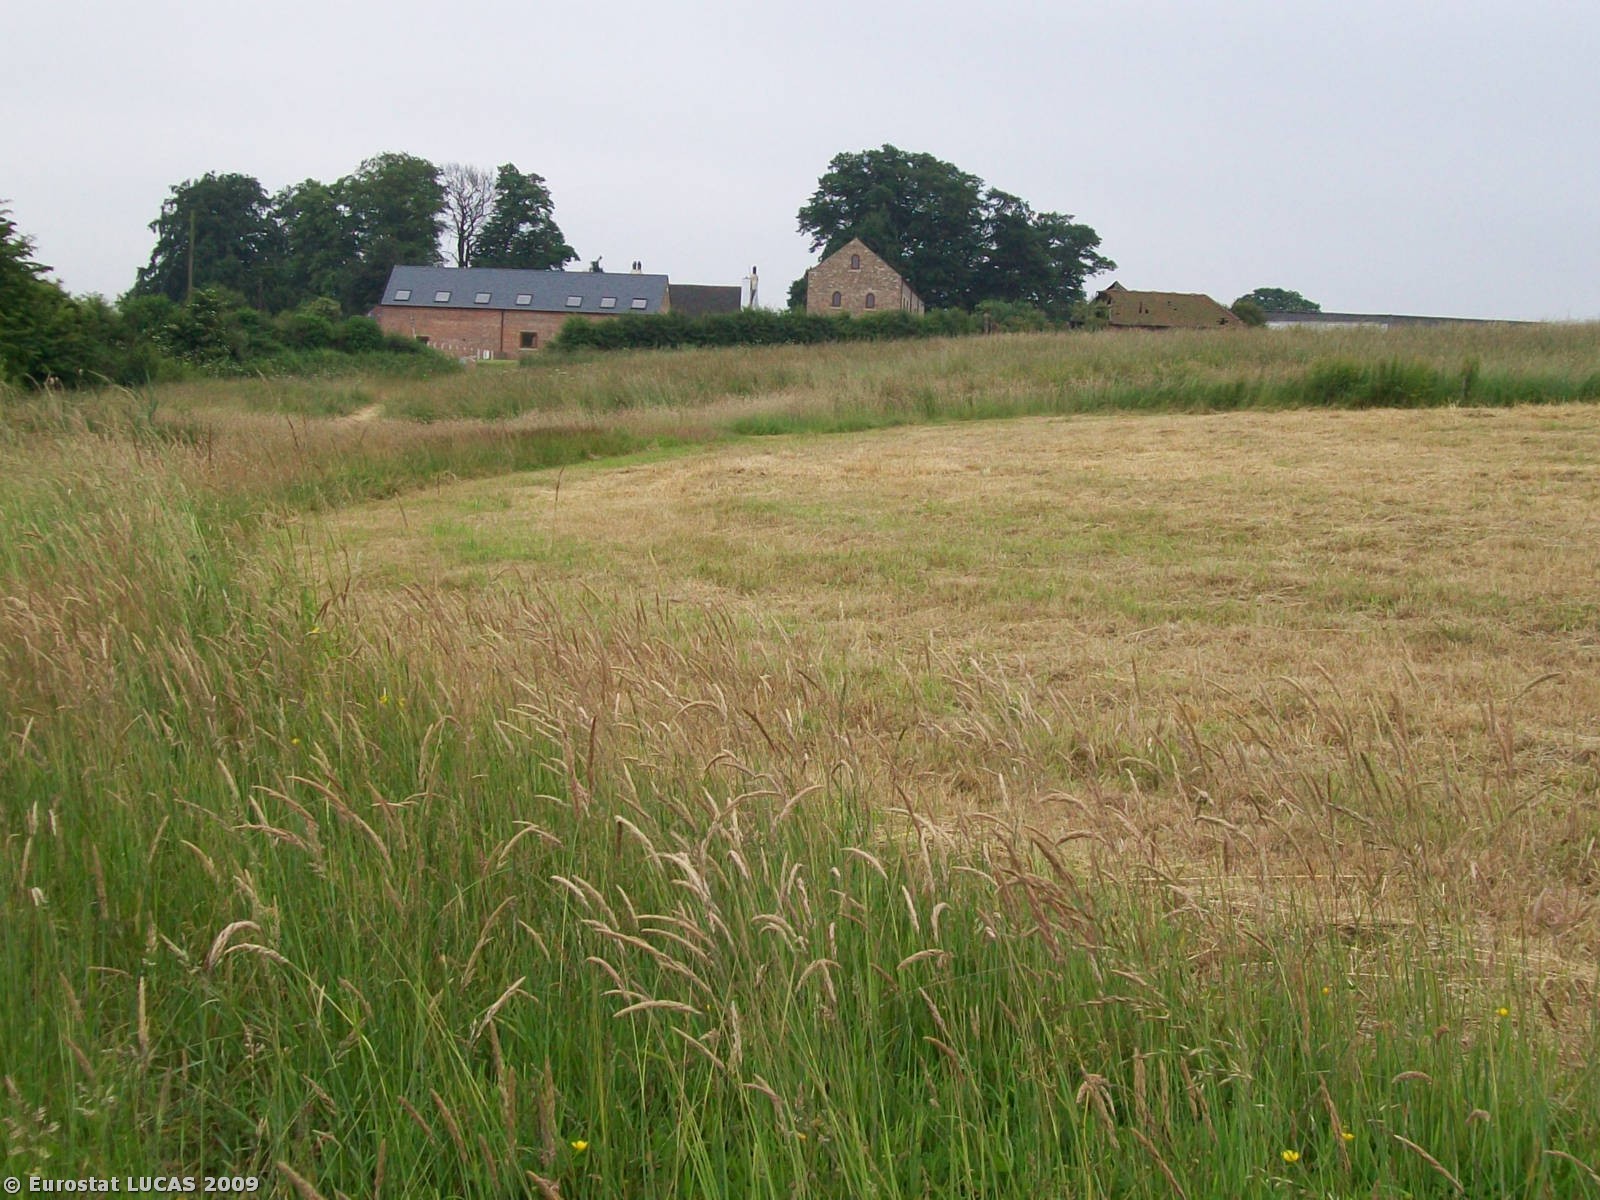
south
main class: Grassland
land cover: Grassland without tree/shrub cover
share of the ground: < 10 %
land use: Agriculture (excluding fallow land and kitchen gardens)
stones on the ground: < 10 %
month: July
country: GB
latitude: 53.8070
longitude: -1.3917
